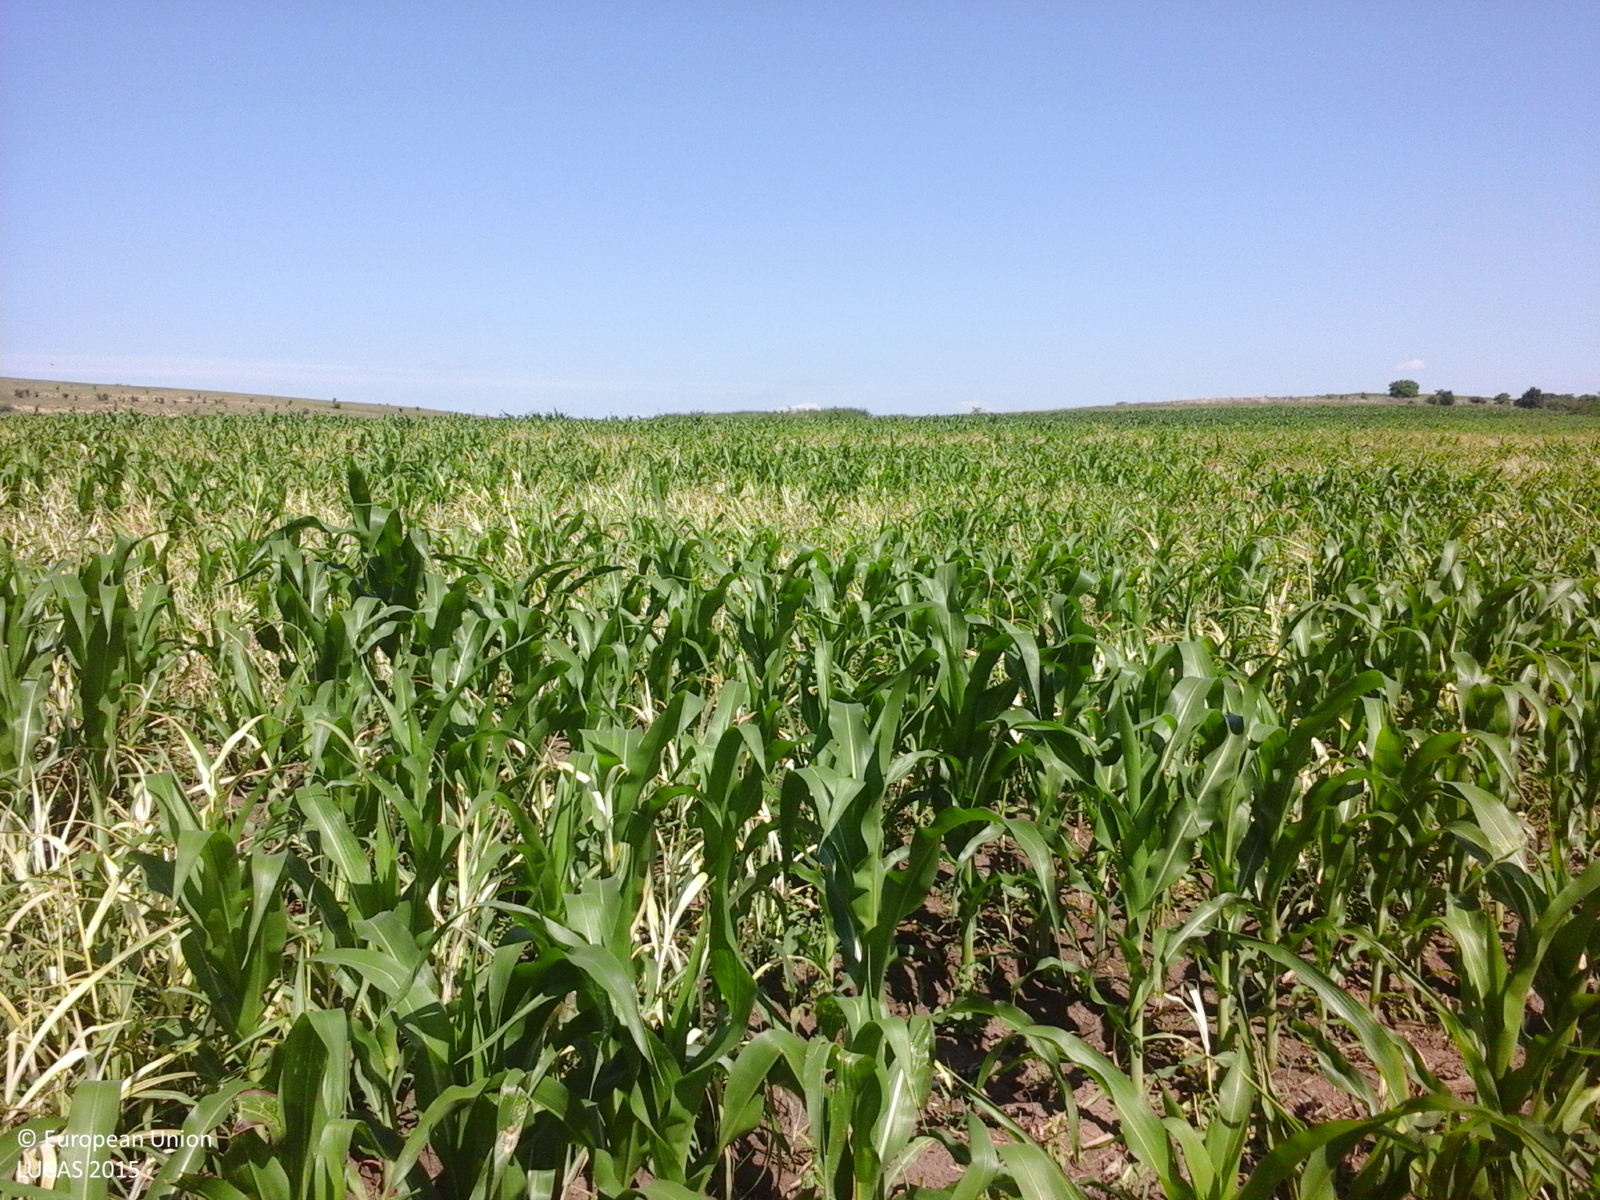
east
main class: Cropland
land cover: Maize
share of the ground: 50 - 75 %
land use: Agriculture (excluding fallow land and kitchen gardens)
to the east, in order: Maize; Spontaneously vegetated surfaces; Grassland with sparse tree/shrub cover
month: June
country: RO
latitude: 47.5208
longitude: 27.3107
